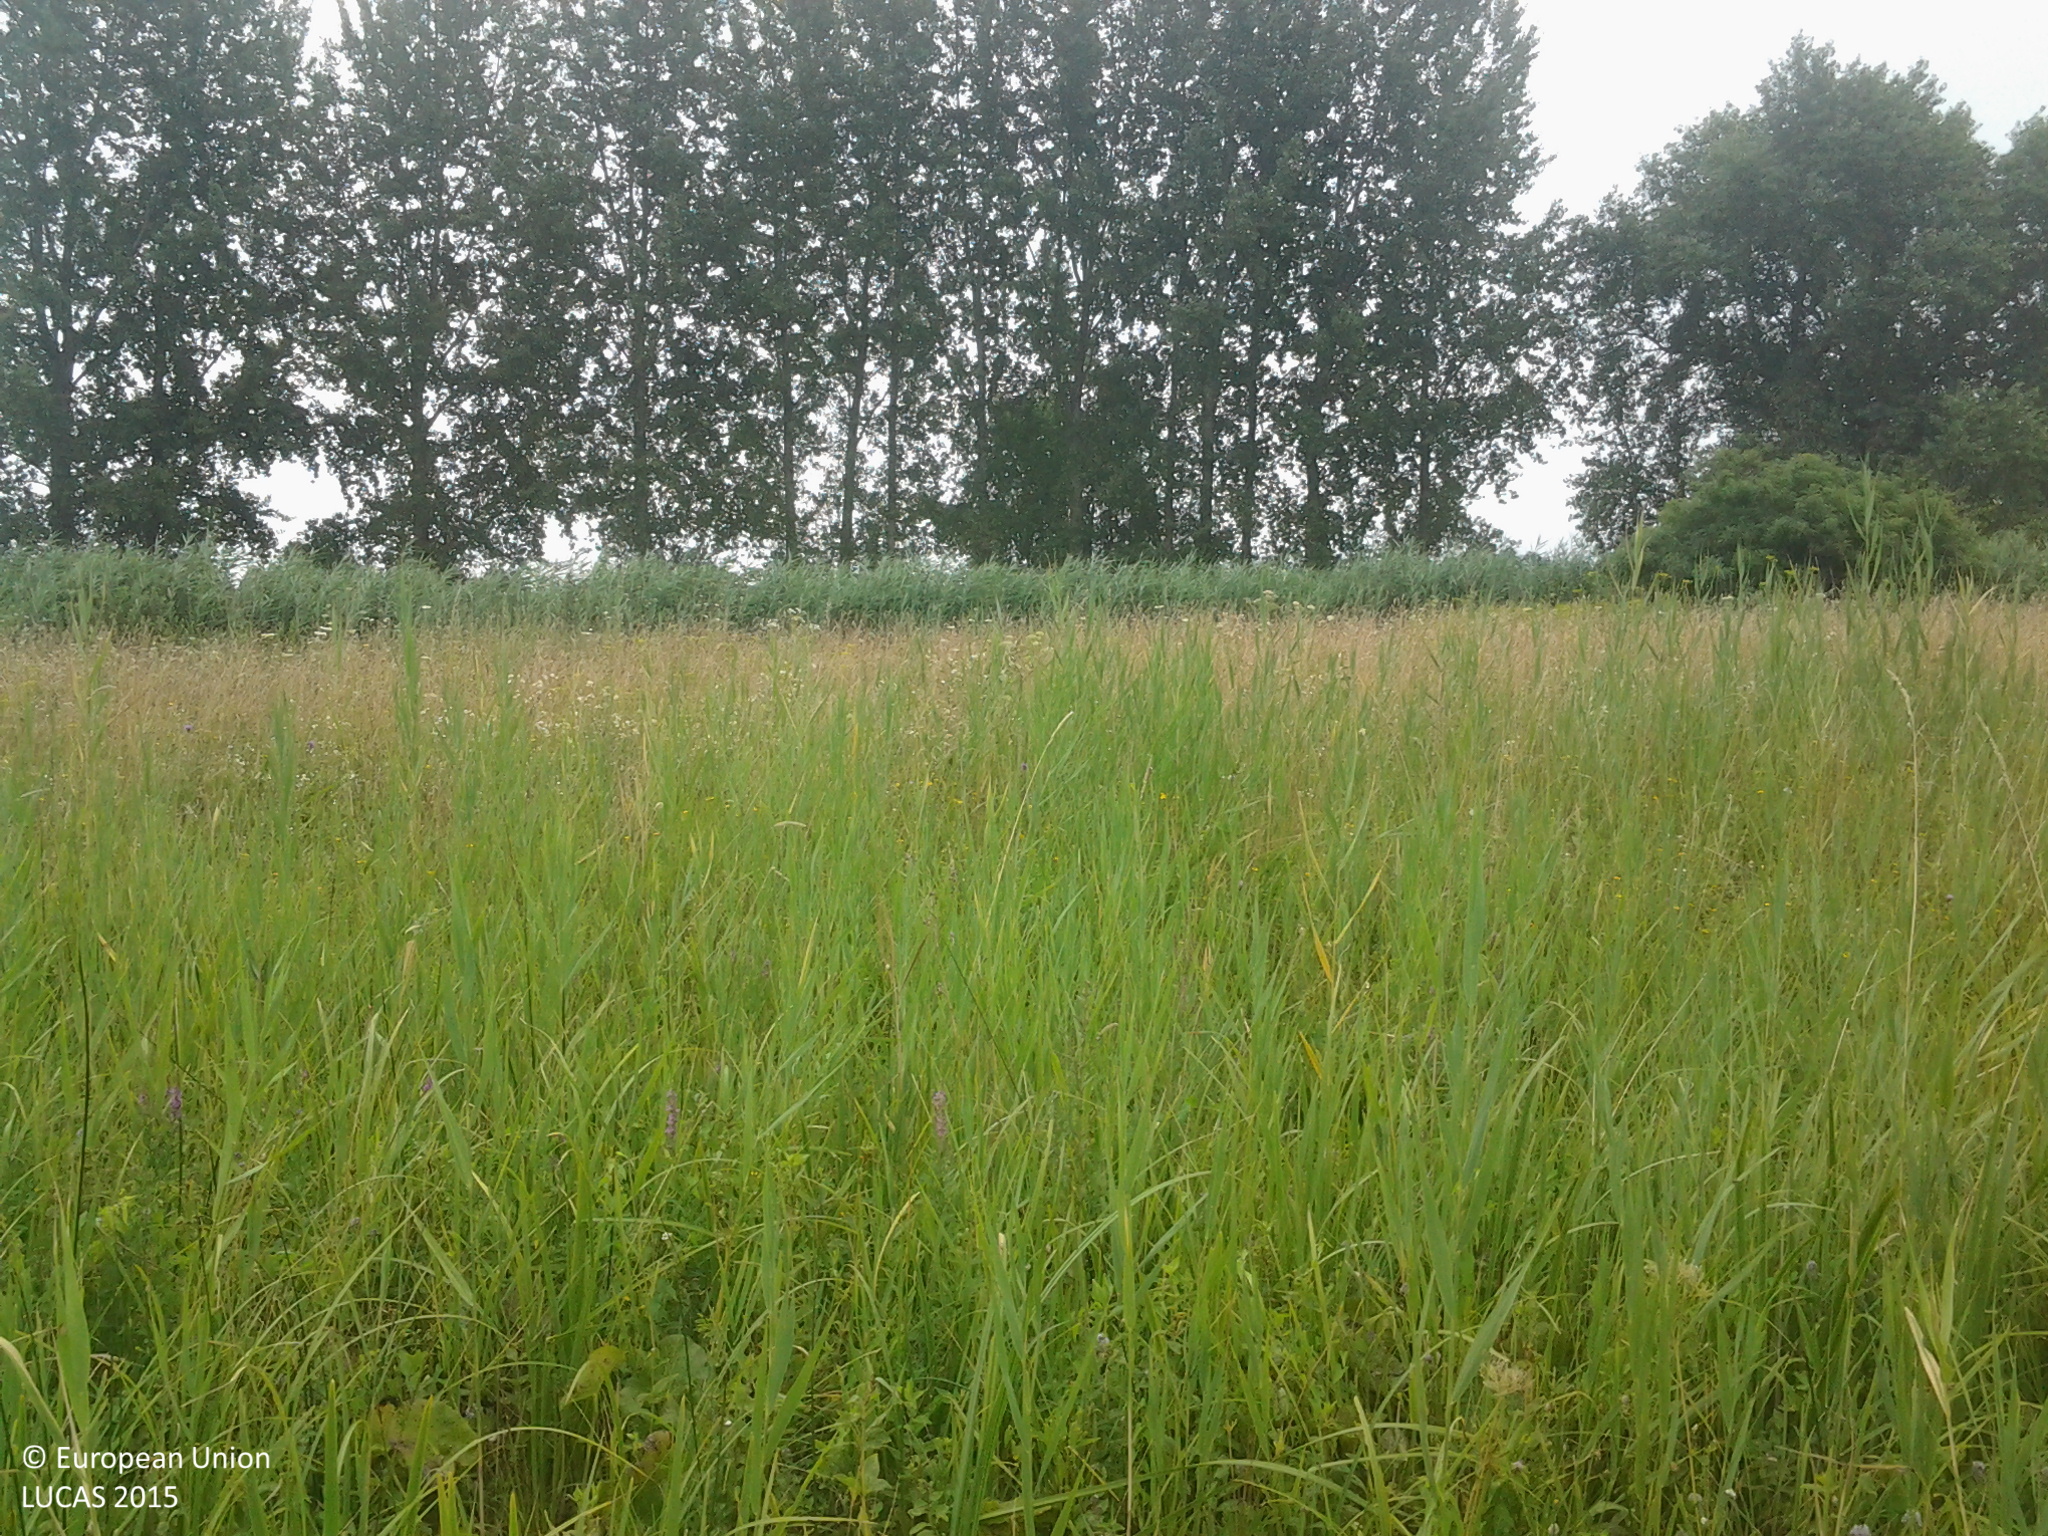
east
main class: Grassland
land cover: Grassland without tree/shrub cover
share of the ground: > 75 %
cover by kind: herbaceous plants 100 %
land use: Agriculture (excluding fallow land and kitchen gardens)
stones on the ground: < 10 %
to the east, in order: Grassland without tree/shrub cover; Tracks; Spontaneously vegetated surfaces; Inland fresh running water; Spontaneously vegetated surfaces; Tracks; Grass margins; Lines of trees; Grassland without tree/shrub cover; Tracks; Grassland without tree/shrub cover; Tracks; Grassland without tree/shrub cover
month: July
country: HU
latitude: 46.6426
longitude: 19.2000
